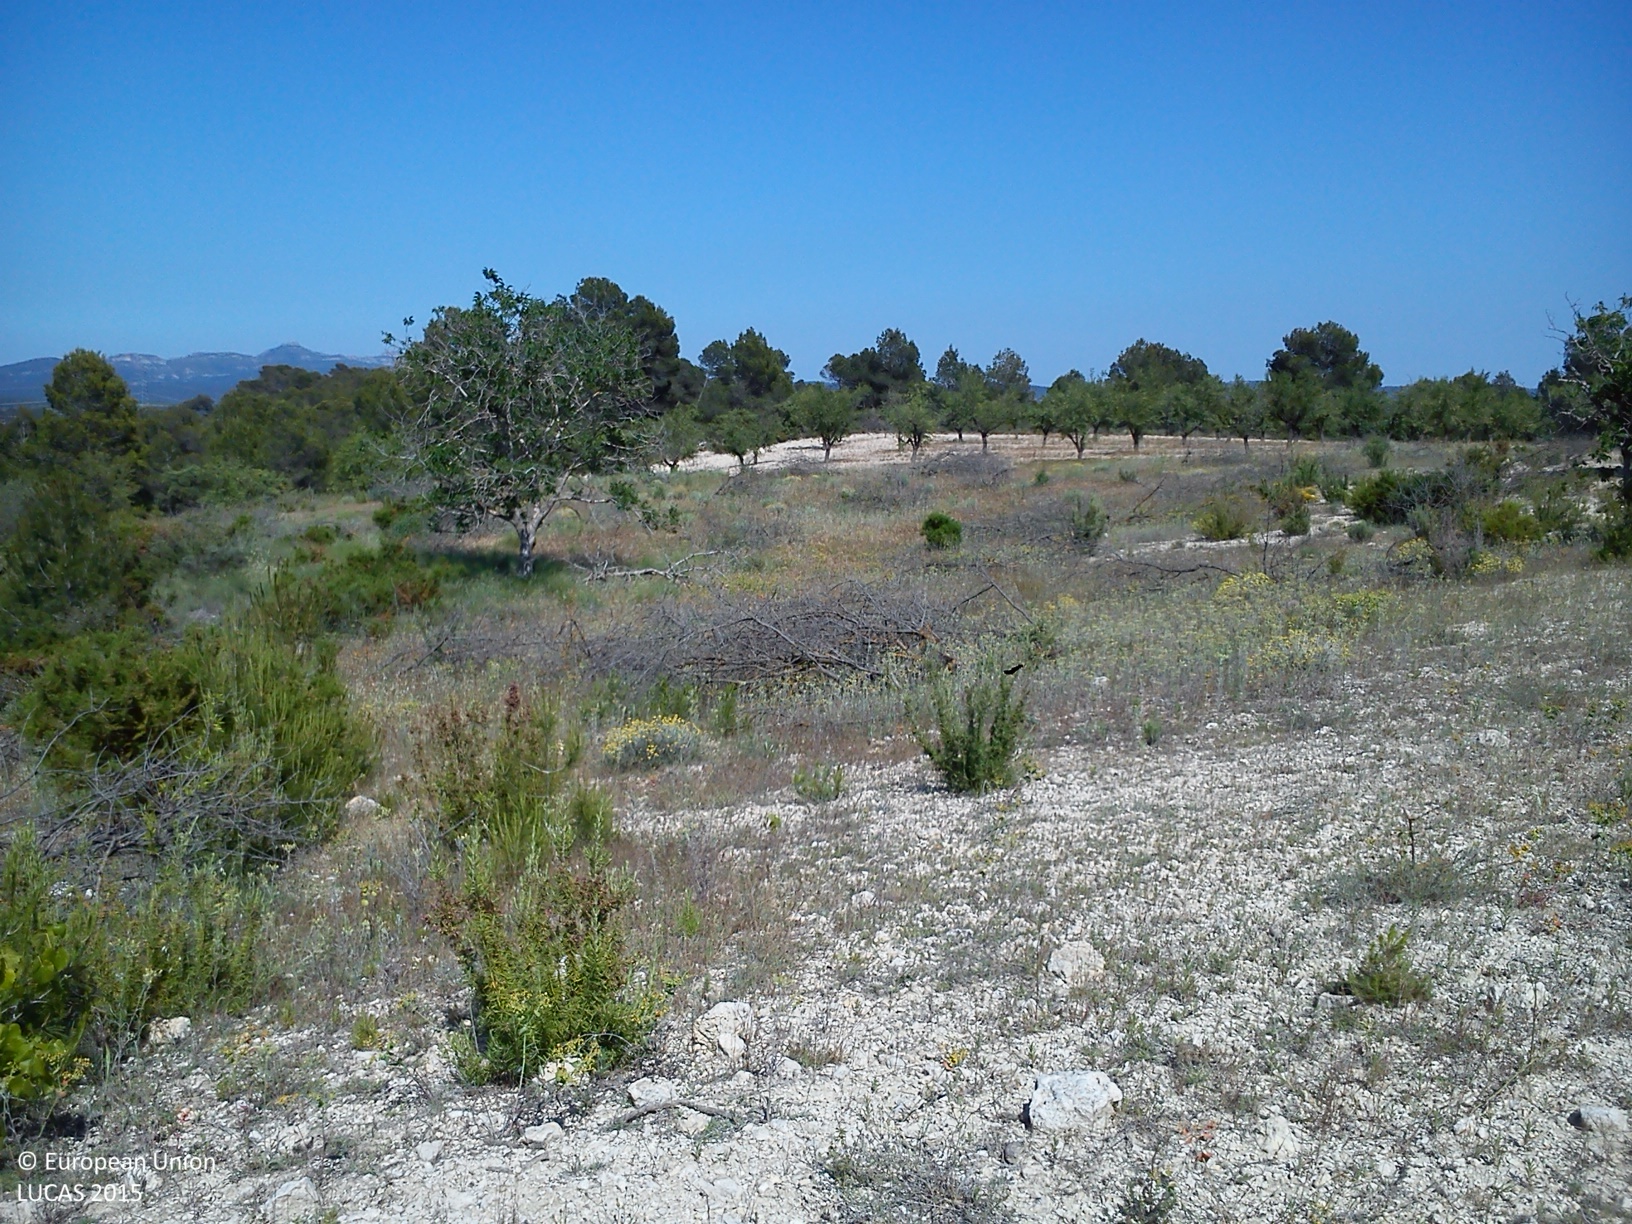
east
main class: Shrubland
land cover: Shrubland with sparse tree cover
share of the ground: 10 - 25 %
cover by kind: herbaceous plants 40 %, unconsolidated bare surface 35 %, shrubs 20 %, coniferous forest trees 5 %
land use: Abandoned areas
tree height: < 5 m
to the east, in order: Shrubland with sparse tree cover; Grassland without tree/shrub cover; Nuts trees; Pine dominated coniferous woodland
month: June
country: ES
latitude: 39.3098
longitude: -1.0746
